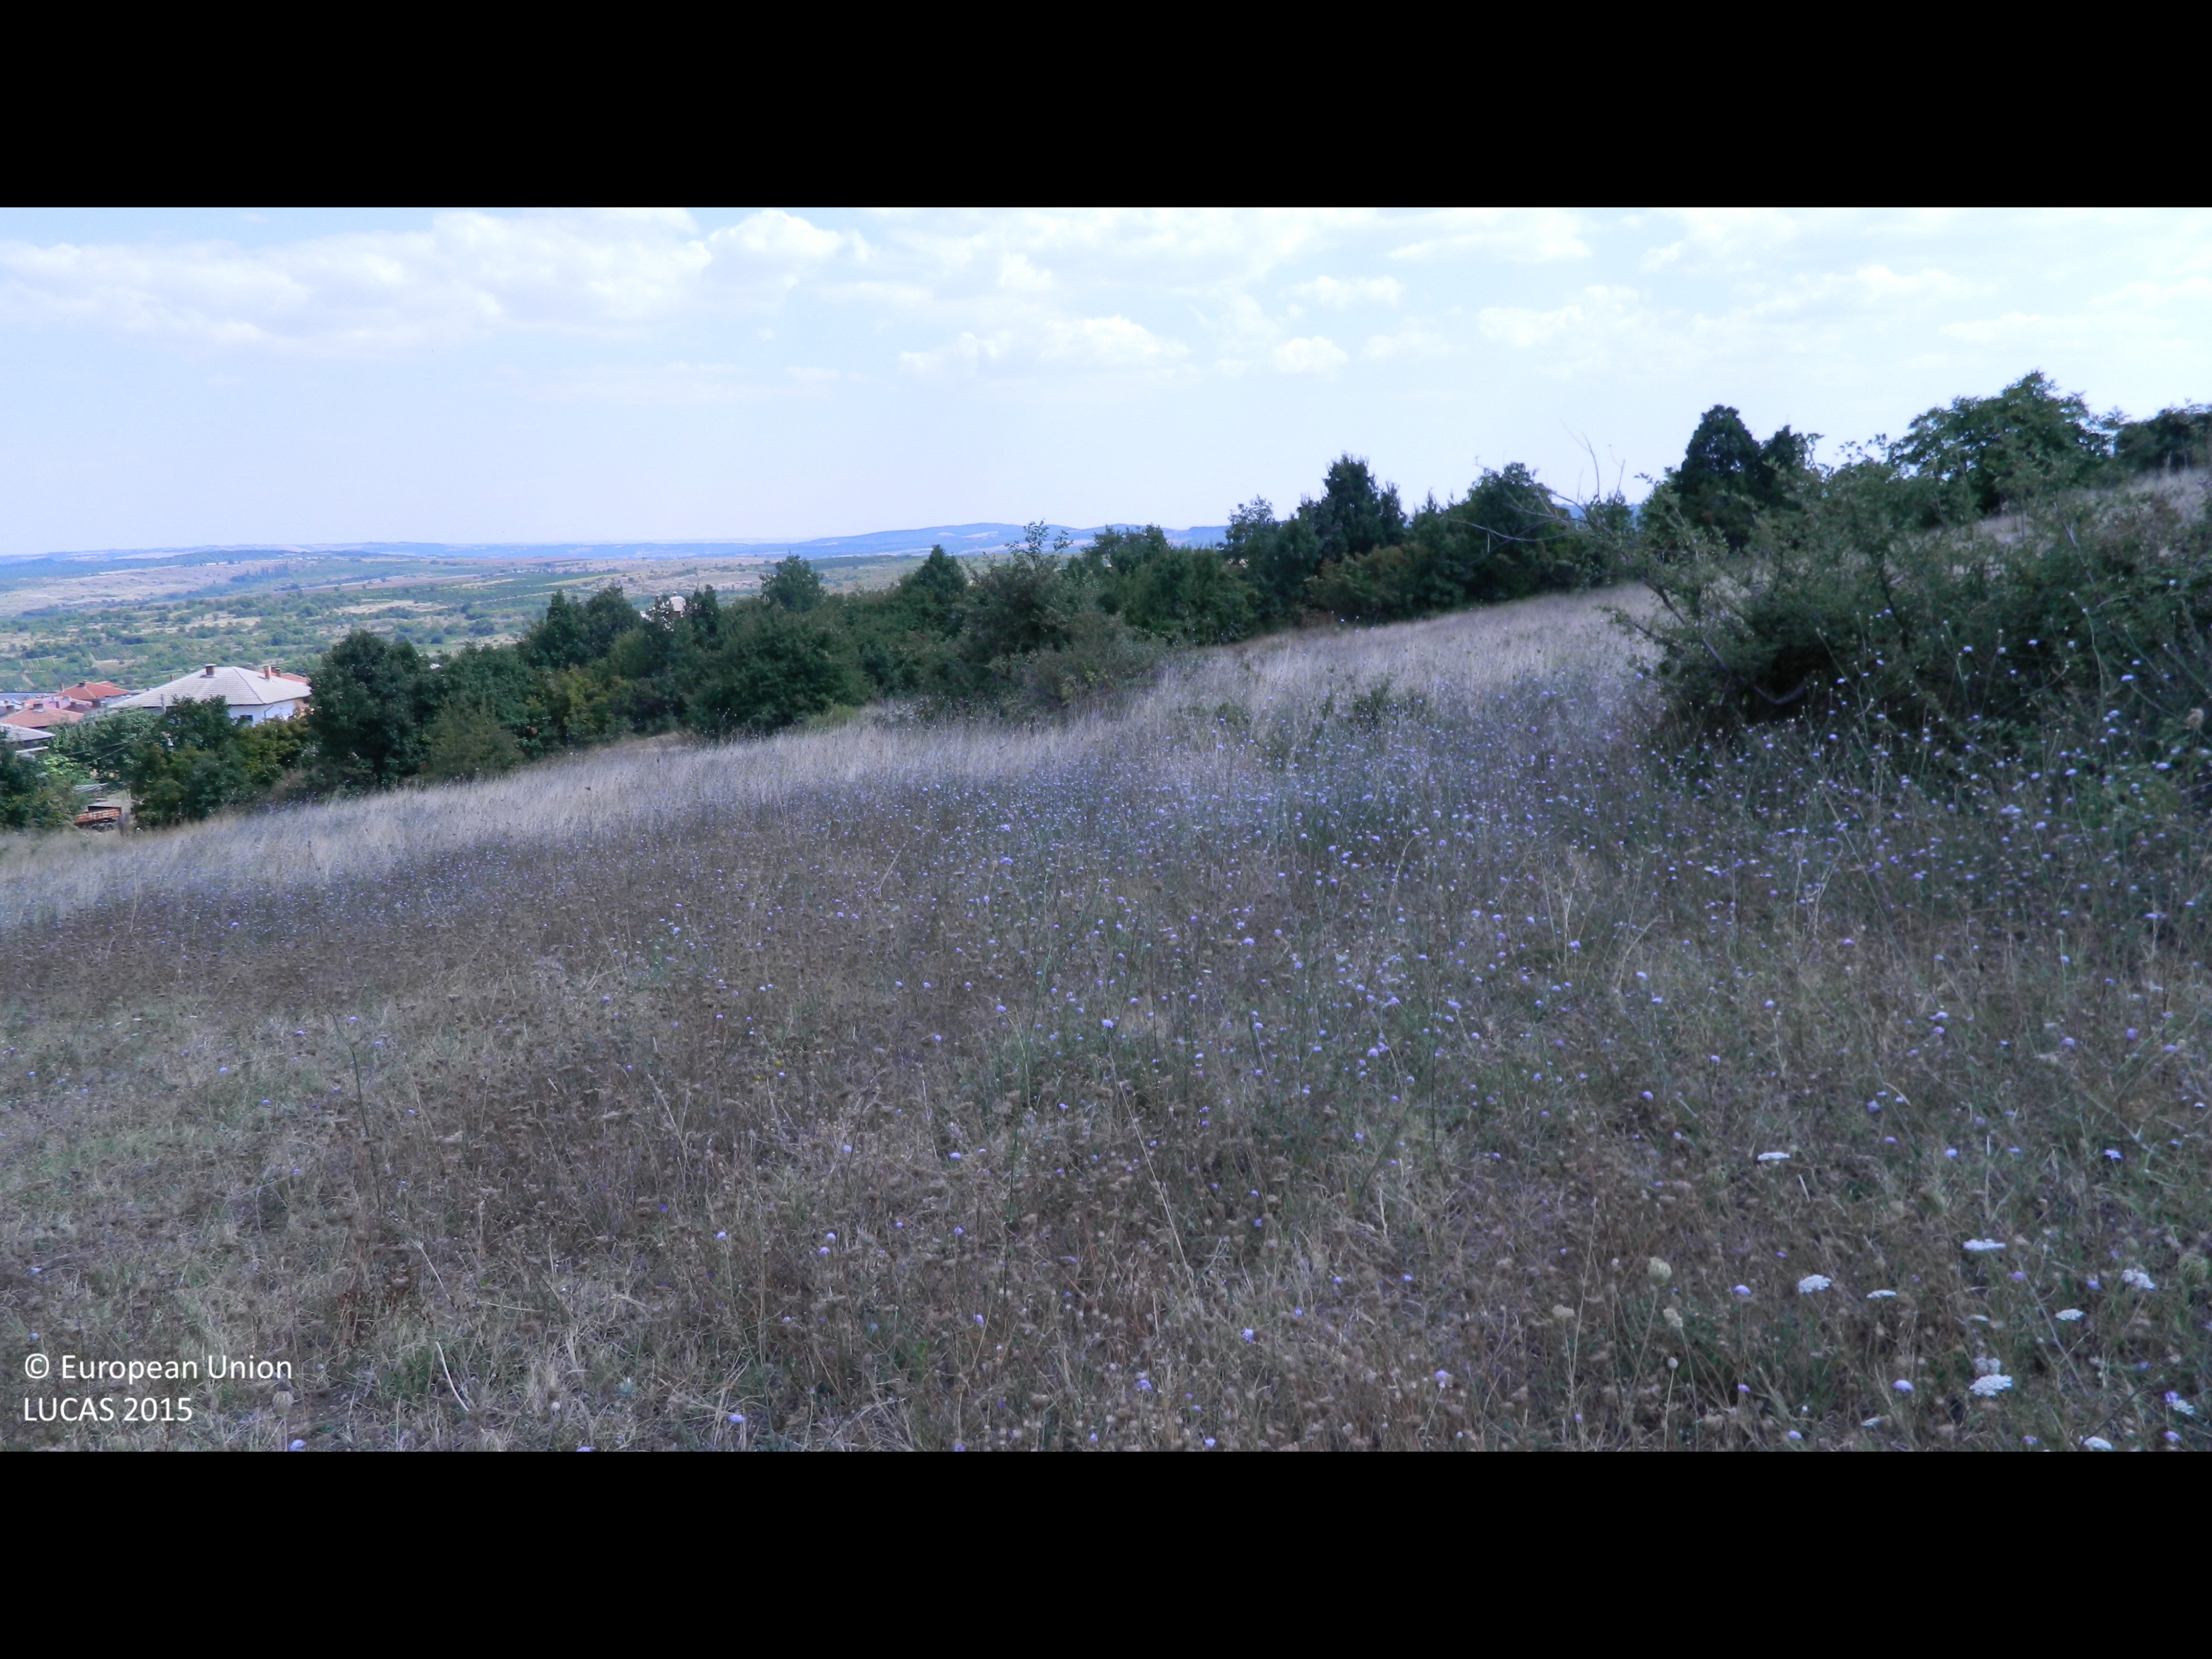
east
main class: Grassland
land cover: Grassland without tree/shrub cover
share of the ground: > 75 %
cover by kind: herbaceous plants 95 %, shrubs 5 %
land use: Agriculture (excluding fallow land and kitchen gardens)
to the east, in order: Grassland without tree/shrub cover; Grassland with sparse tree/shrub cover; Tracks; Broadleaved woodland; Grass margins; Tracks; Grassland without tree/shrub cover; Grass margins; Artificial constructions in urban areas
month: August
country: BG
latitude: 41.5190
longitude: 26.1157
